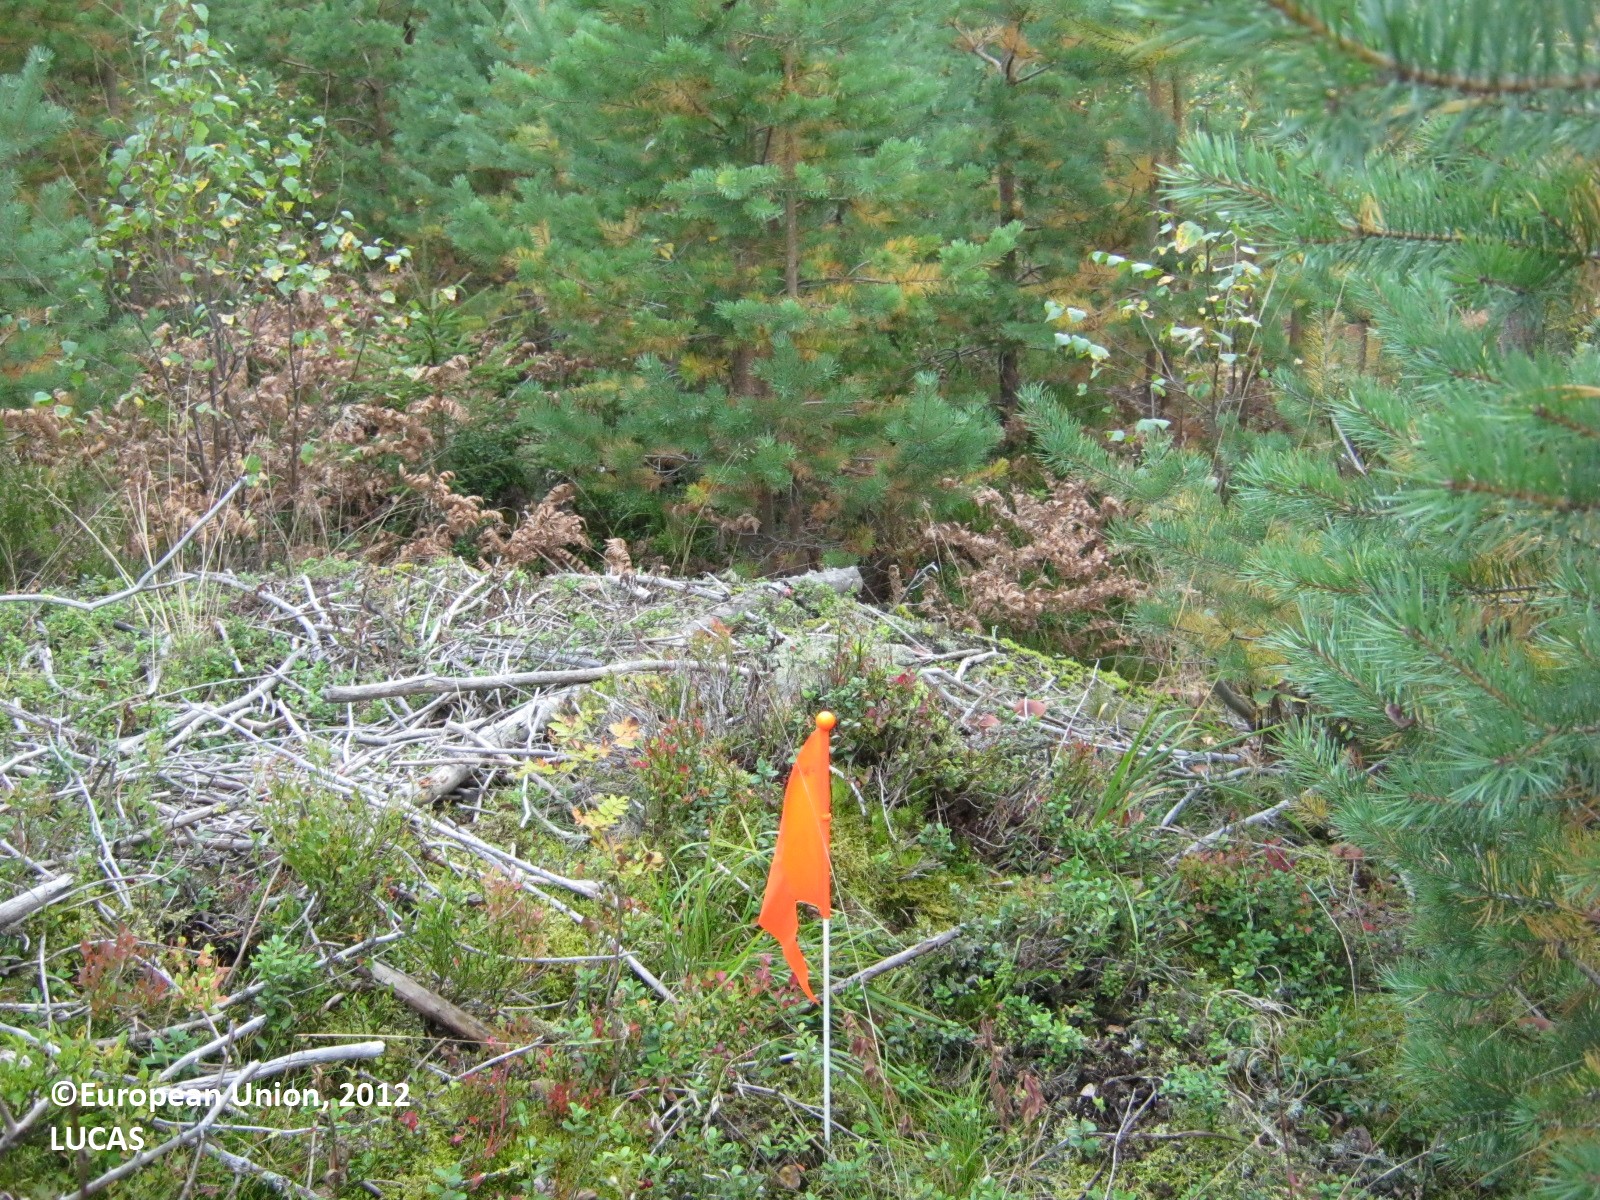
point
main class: Woodland
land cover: Pine dominated coniferous woodland
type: boreal forest
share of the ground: > 75 %
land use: Forestry
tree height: < 5 m
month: September
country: FI
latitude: 60.8488
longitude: 27.9583
